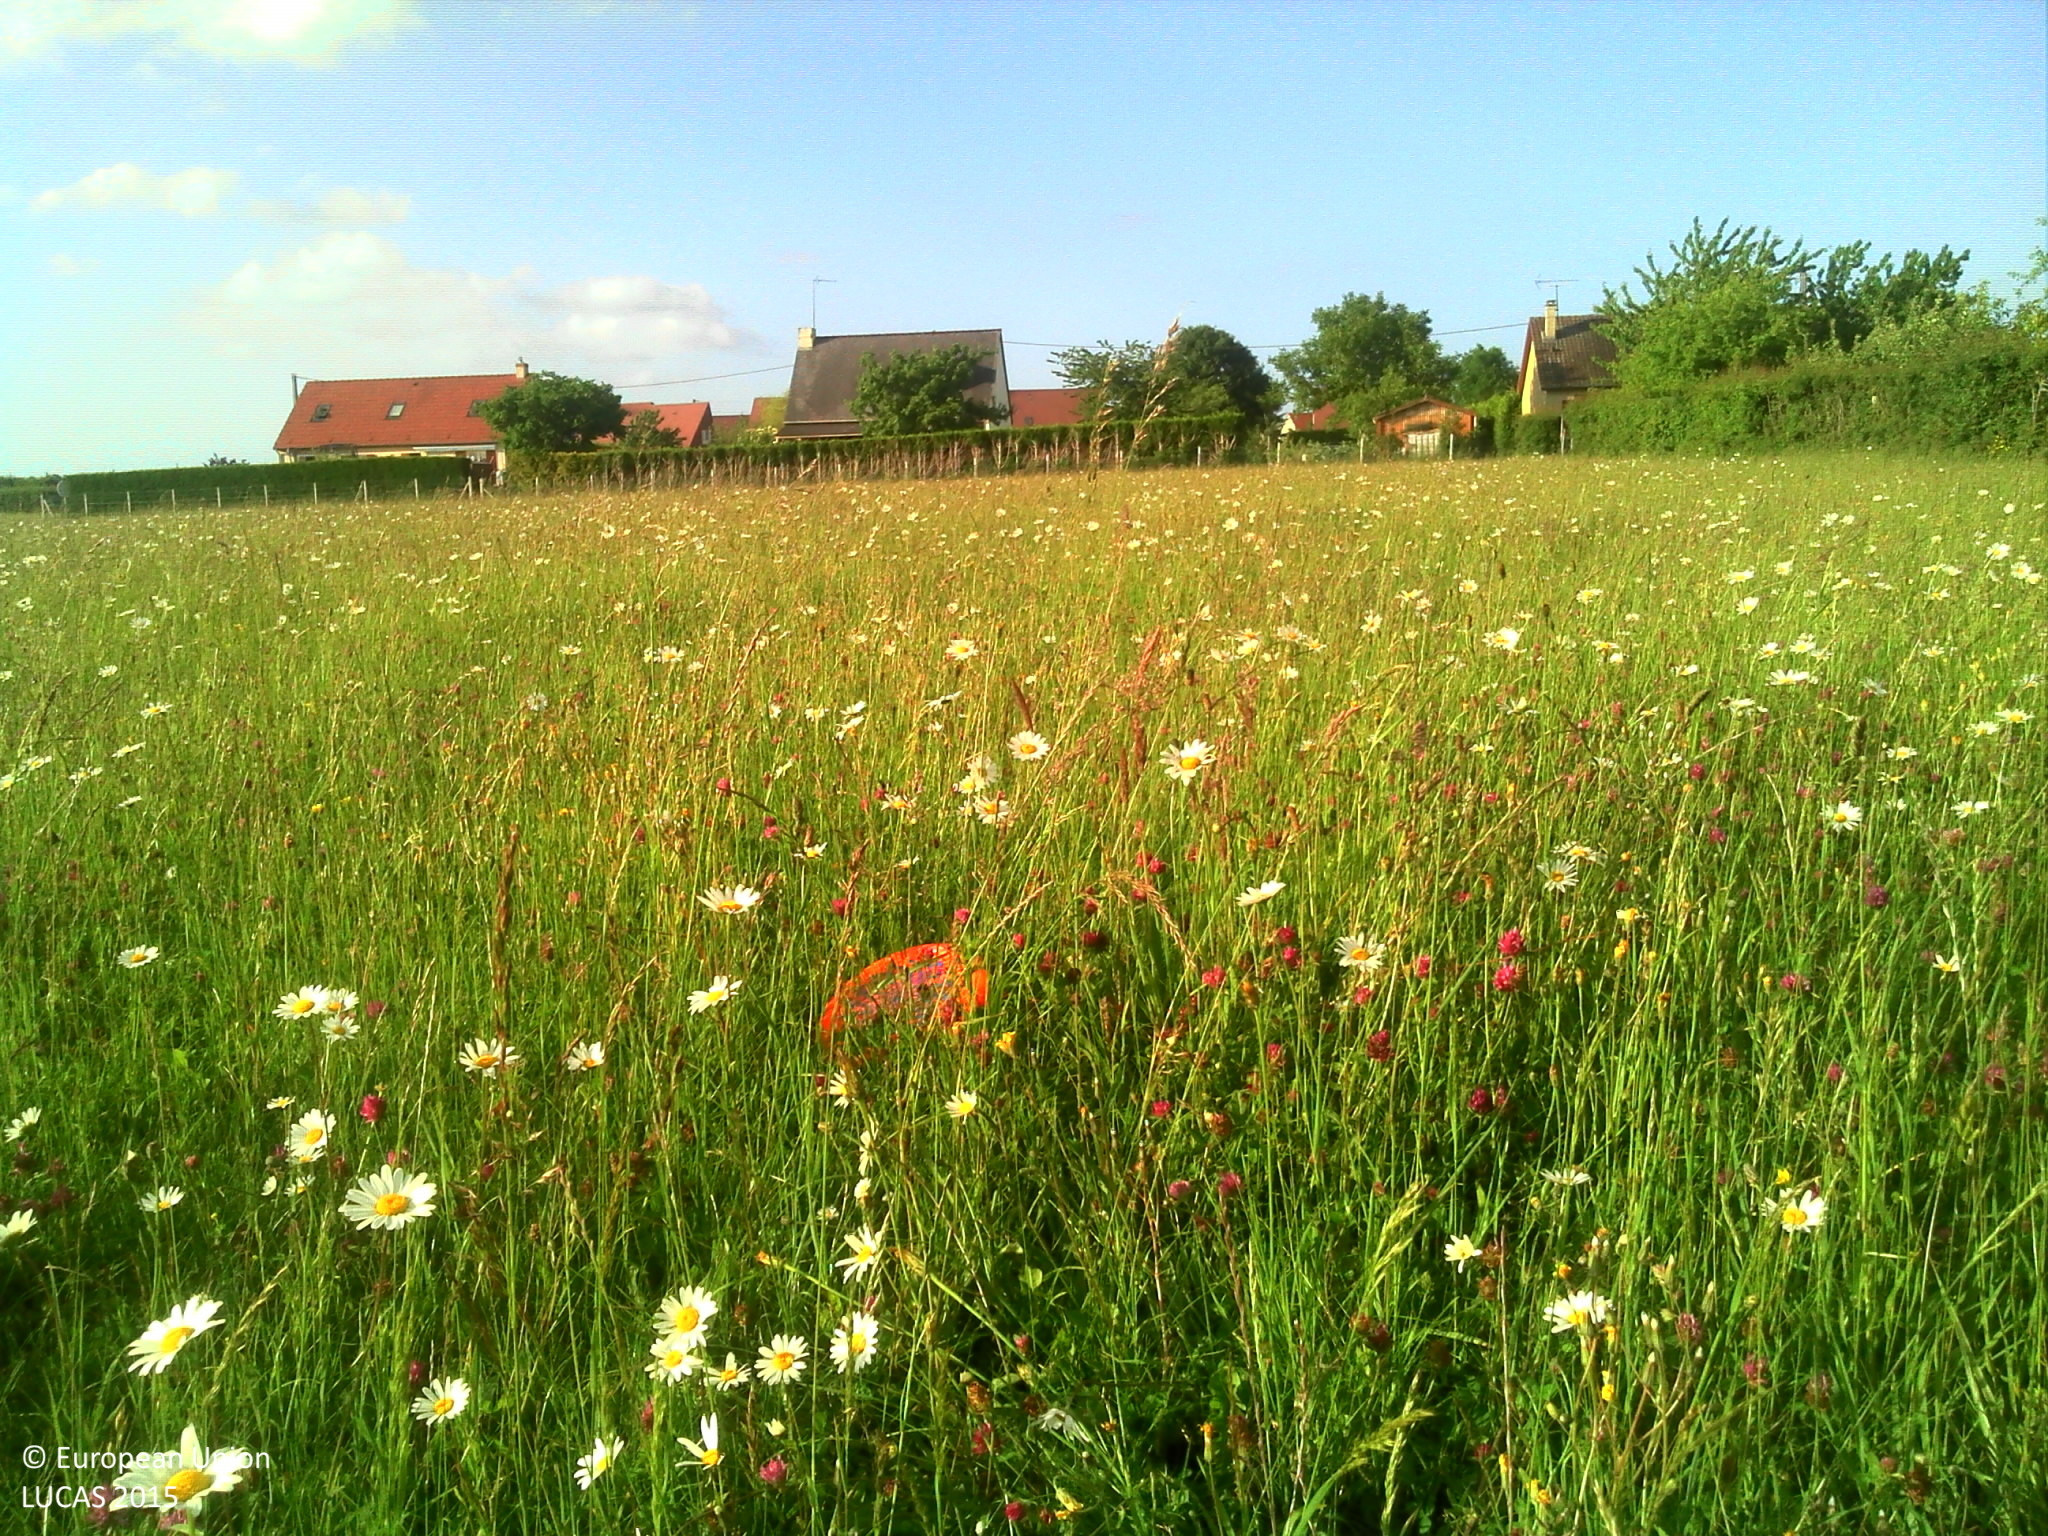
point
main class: Grassland
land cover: Grassland without tree/shrub cover
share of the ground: > 75 %
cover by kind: herbaceous plants 95 %
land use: Agriculture (excluding fallow land and kitchen gardens)
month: June
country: FR
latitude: 48.8099
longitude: 0.0983
